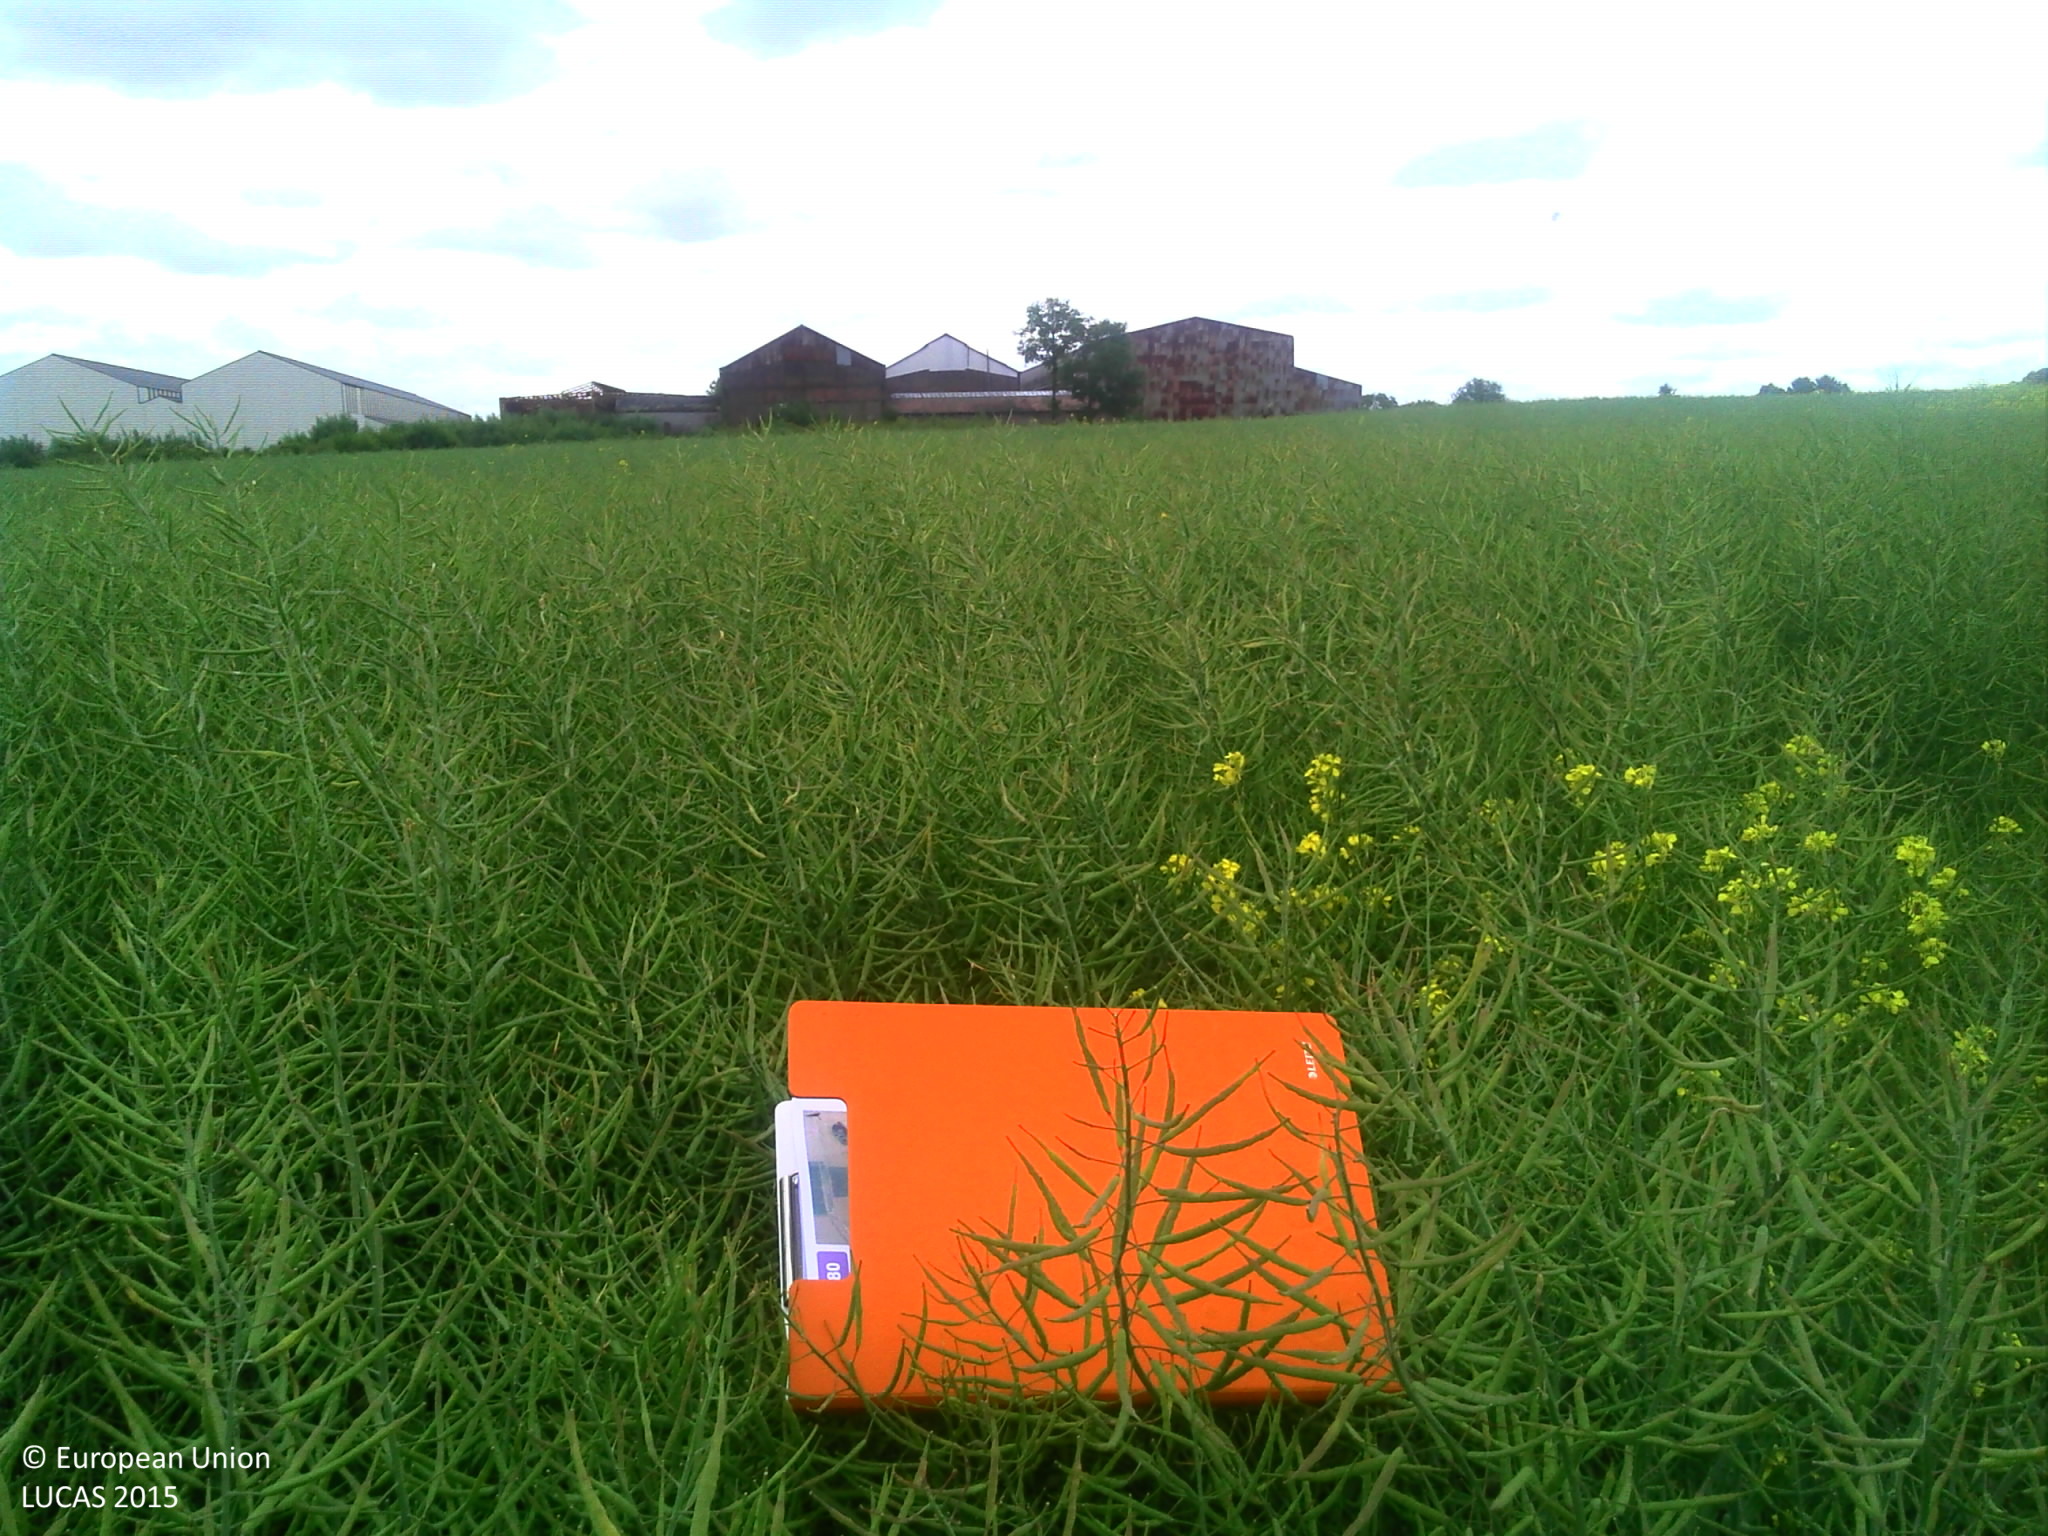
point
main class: Cropland
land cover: Rape and turnip rape
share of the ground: > 75 %
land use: Agriculture (excluding fallow land and kitchen gardens)
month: June
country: FR
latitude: 49.7306
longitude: 3.2351
